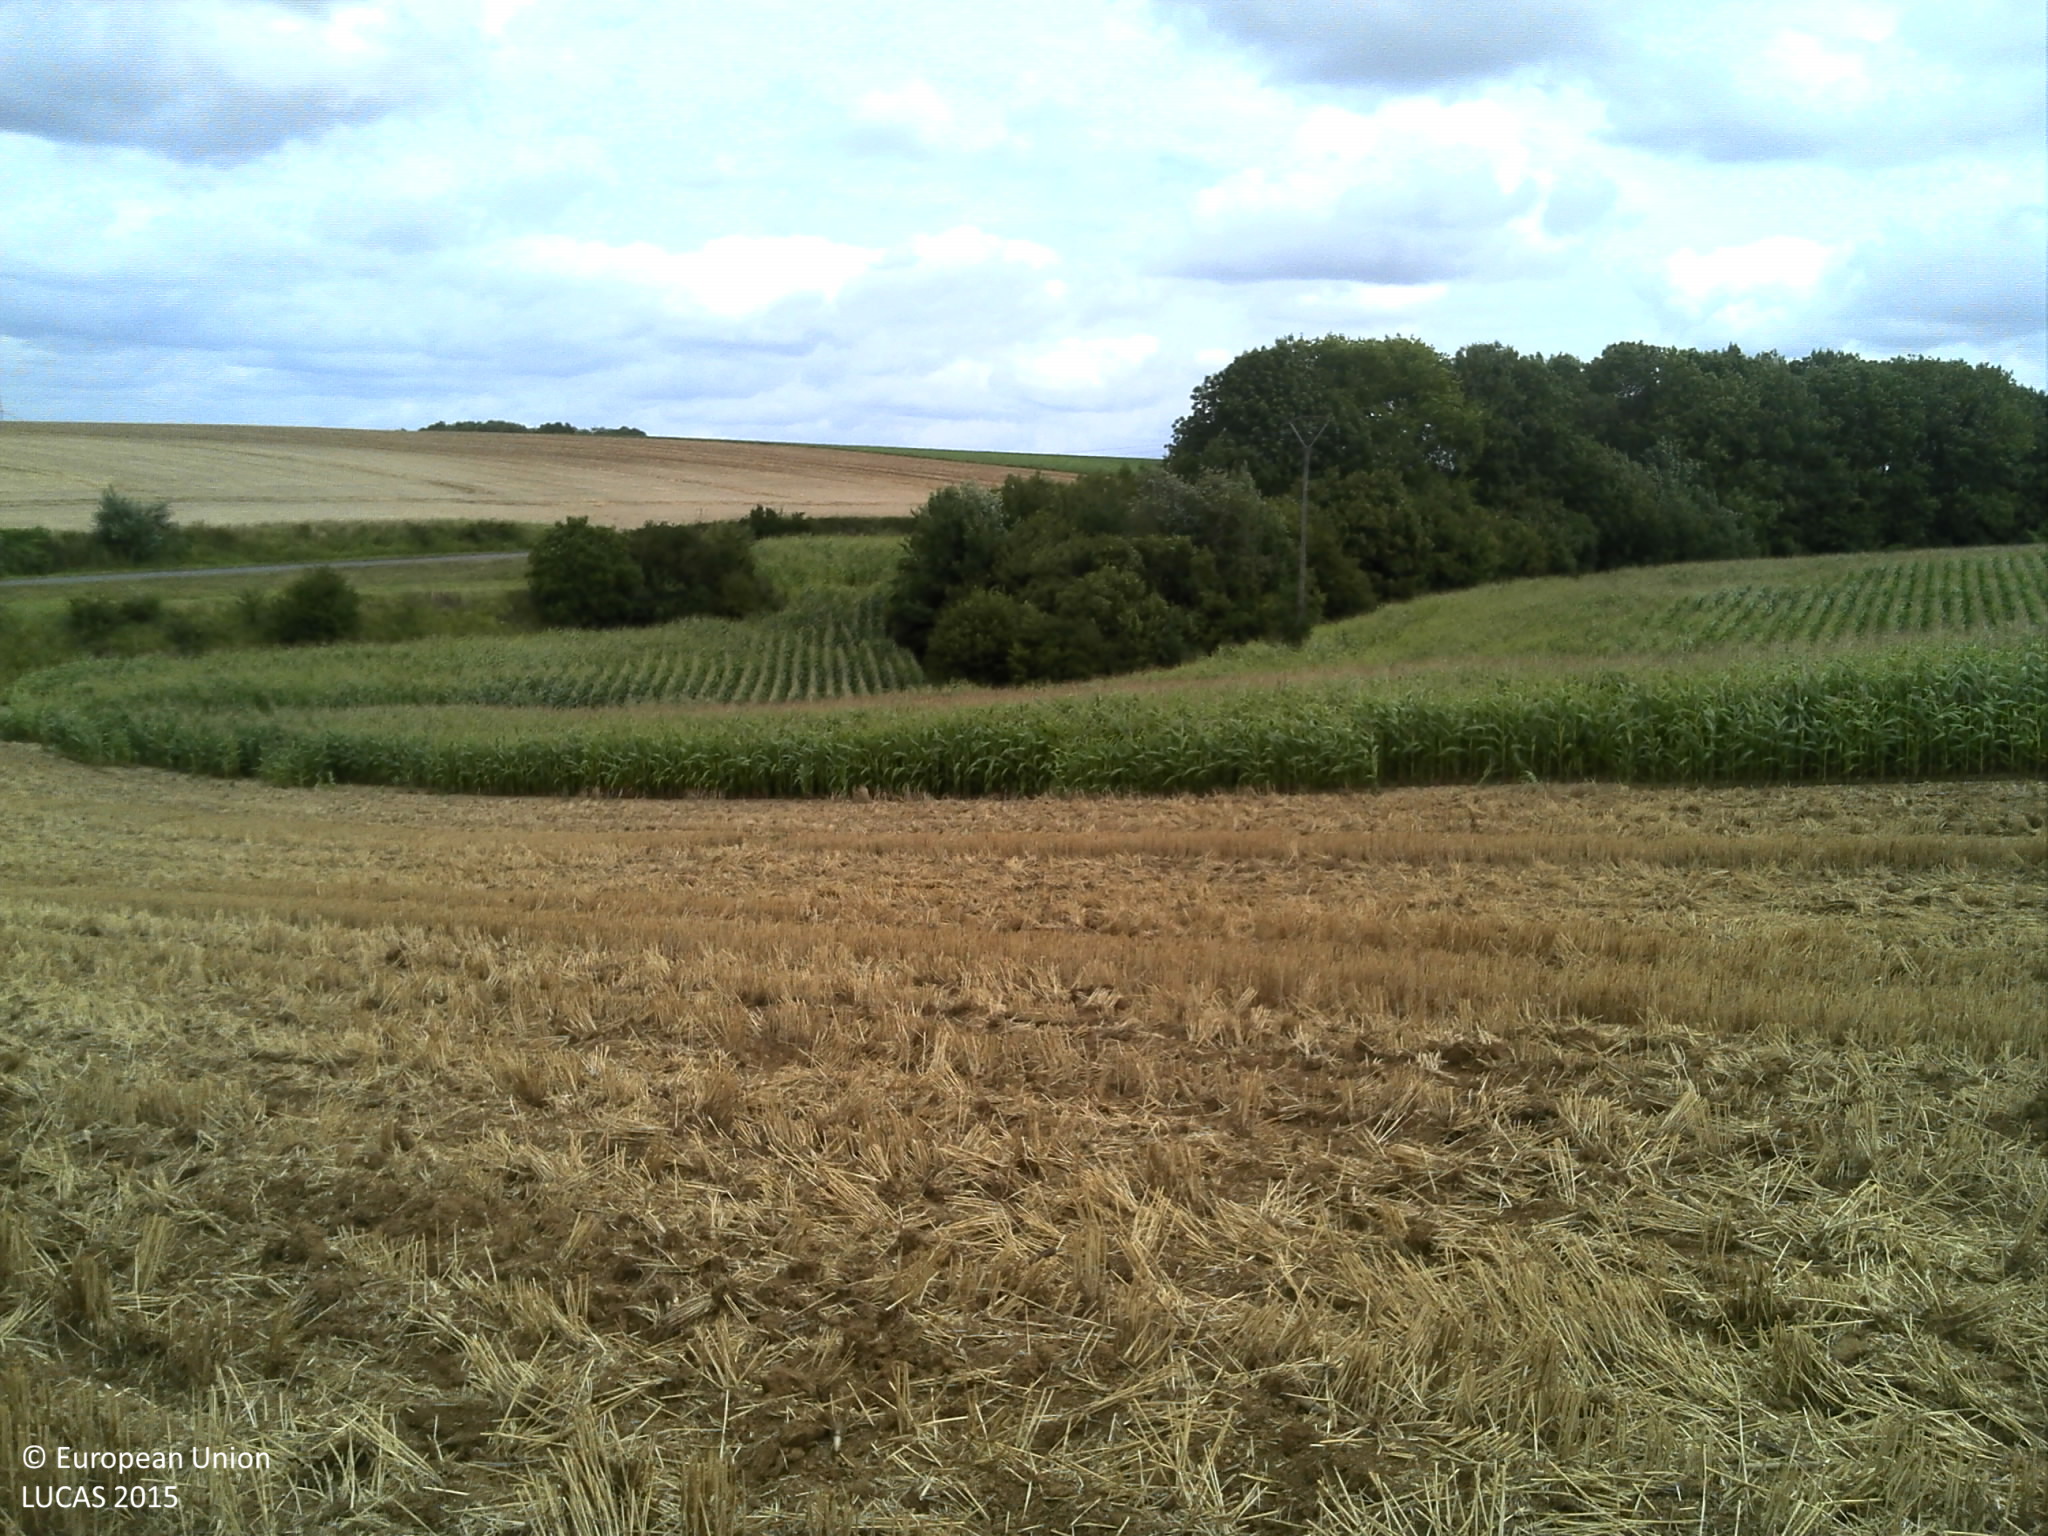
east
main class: Cropland
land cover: Common wheat
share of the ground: 50 - 75 %
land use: Agriculture (excluding fallow land and kitchen gardens)
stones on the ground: < 10 %
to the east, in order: Common wheat; Maize; Electric lines; Maize; Broadleaved woodland; Grass margins; Paved roads, cycling and walking lanes; Grass margins; Single bushes/trees; Sugar beet
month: July
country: FR
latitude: 49.6174
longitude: 4.1125
